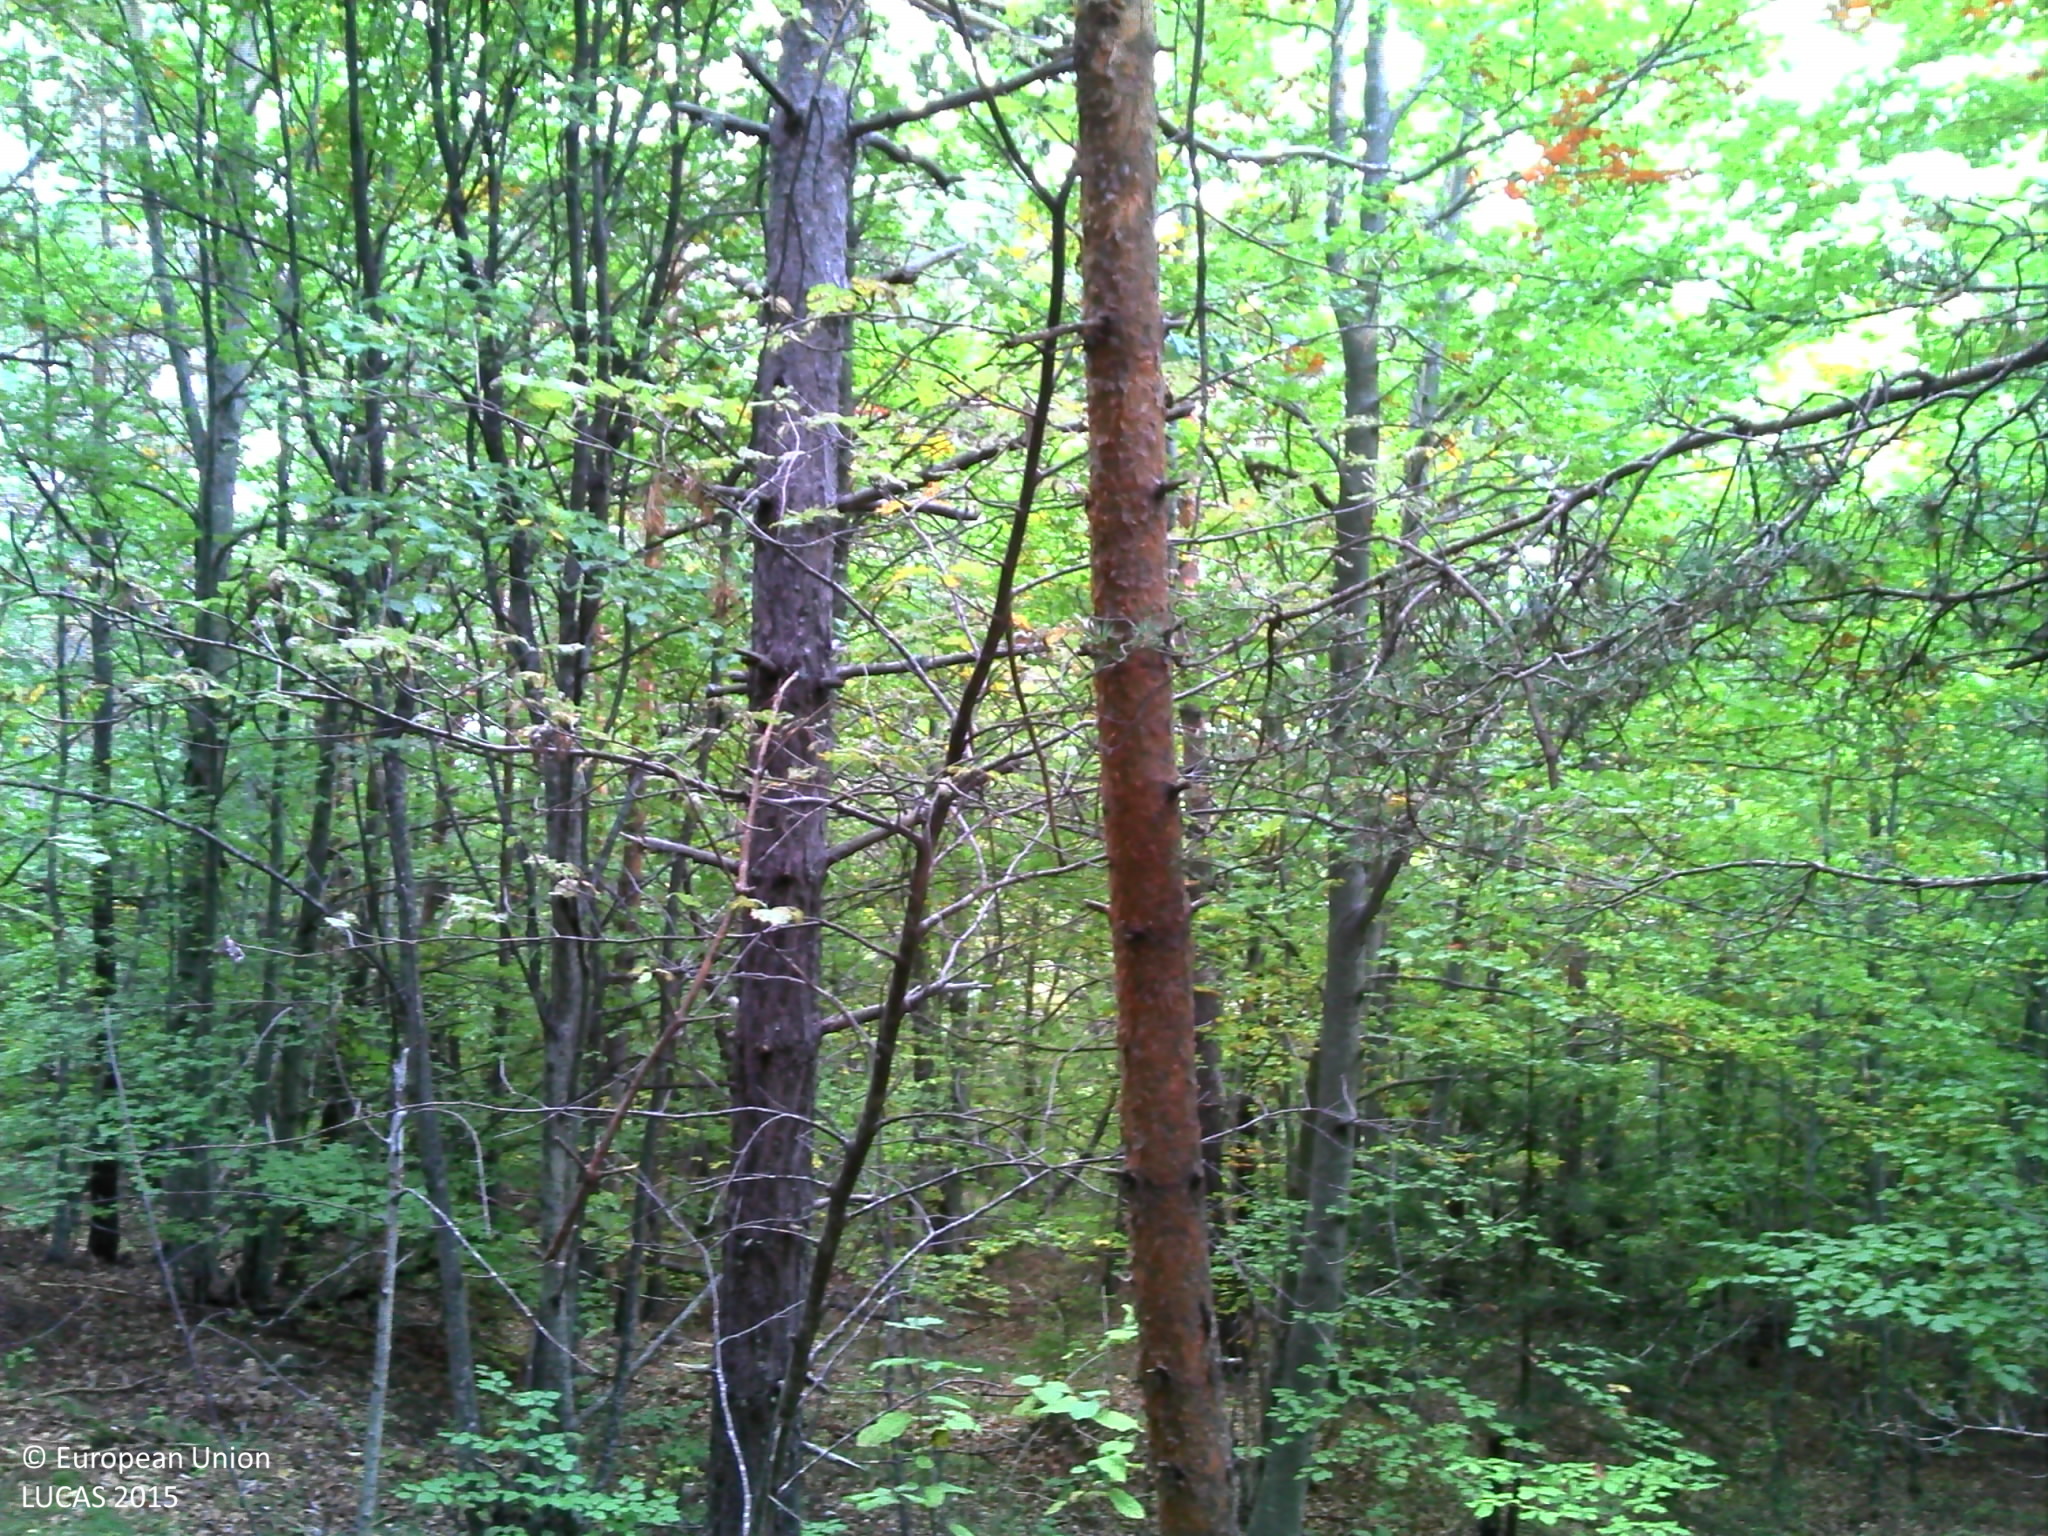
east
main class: Woodland
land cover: Pine dominated mixed woodland
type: alpine coniferous forest
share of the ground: > 75 %
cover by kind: coniferous forest trees 55 %, broadleaved forest trees 35 %, herbaceous plants 5 %, consolidated bare surface 5 %
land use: Forestry
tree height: > 5 m
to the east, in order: Pine dominated mixed woodland; Ditches and canals; Paved roads, cycling and walking lanes; Pine dominated mixed woodland; Paved roads, cycling and walking lanes; Ditches and canals; Pine dominated mixed woodland; Ditches and canals; Paved roads, cycling and walking lanes; Pine dominated mixed woodland; Broadleaved woodland
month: September
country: FR
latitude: 44.5173
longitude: 6.2450
